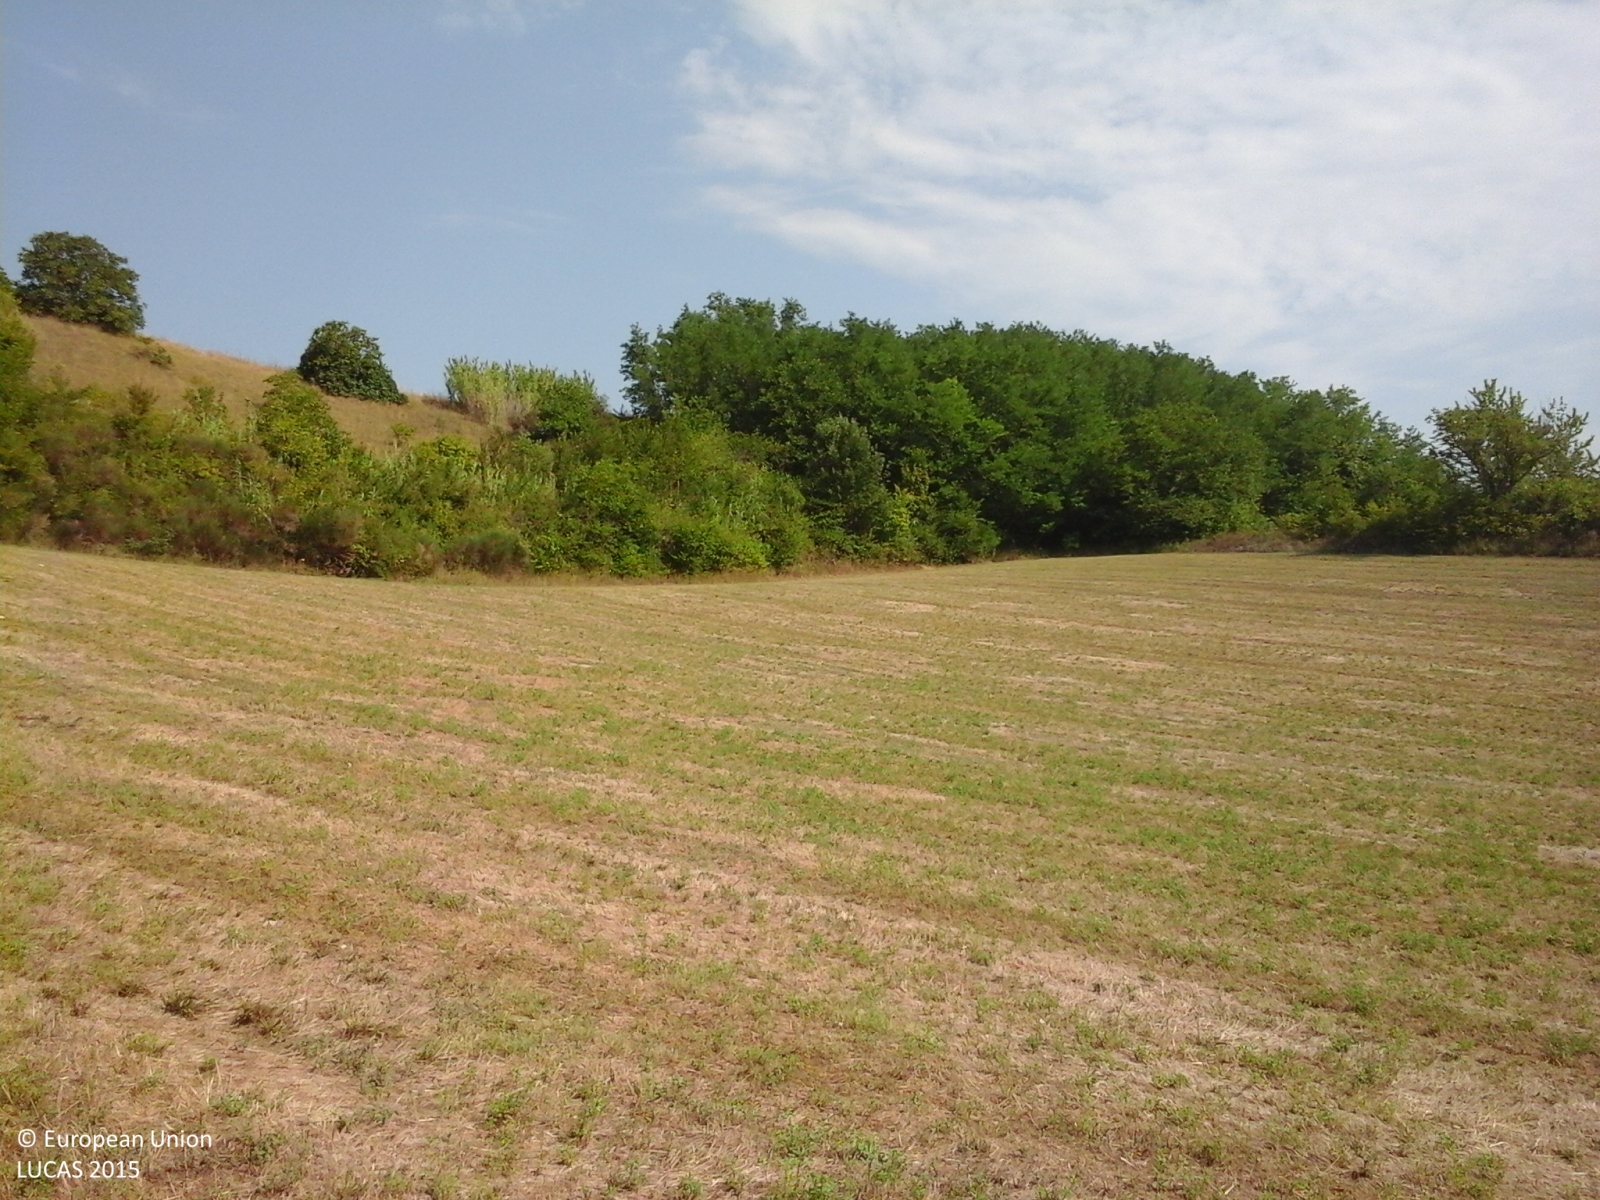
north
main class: Cropland
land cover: Lucerne
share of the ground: > 75 %
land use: Agriculture (excluding fallow land and kitchen gardens)
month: July
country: IT
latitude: 42.1479
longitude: 13.8235
